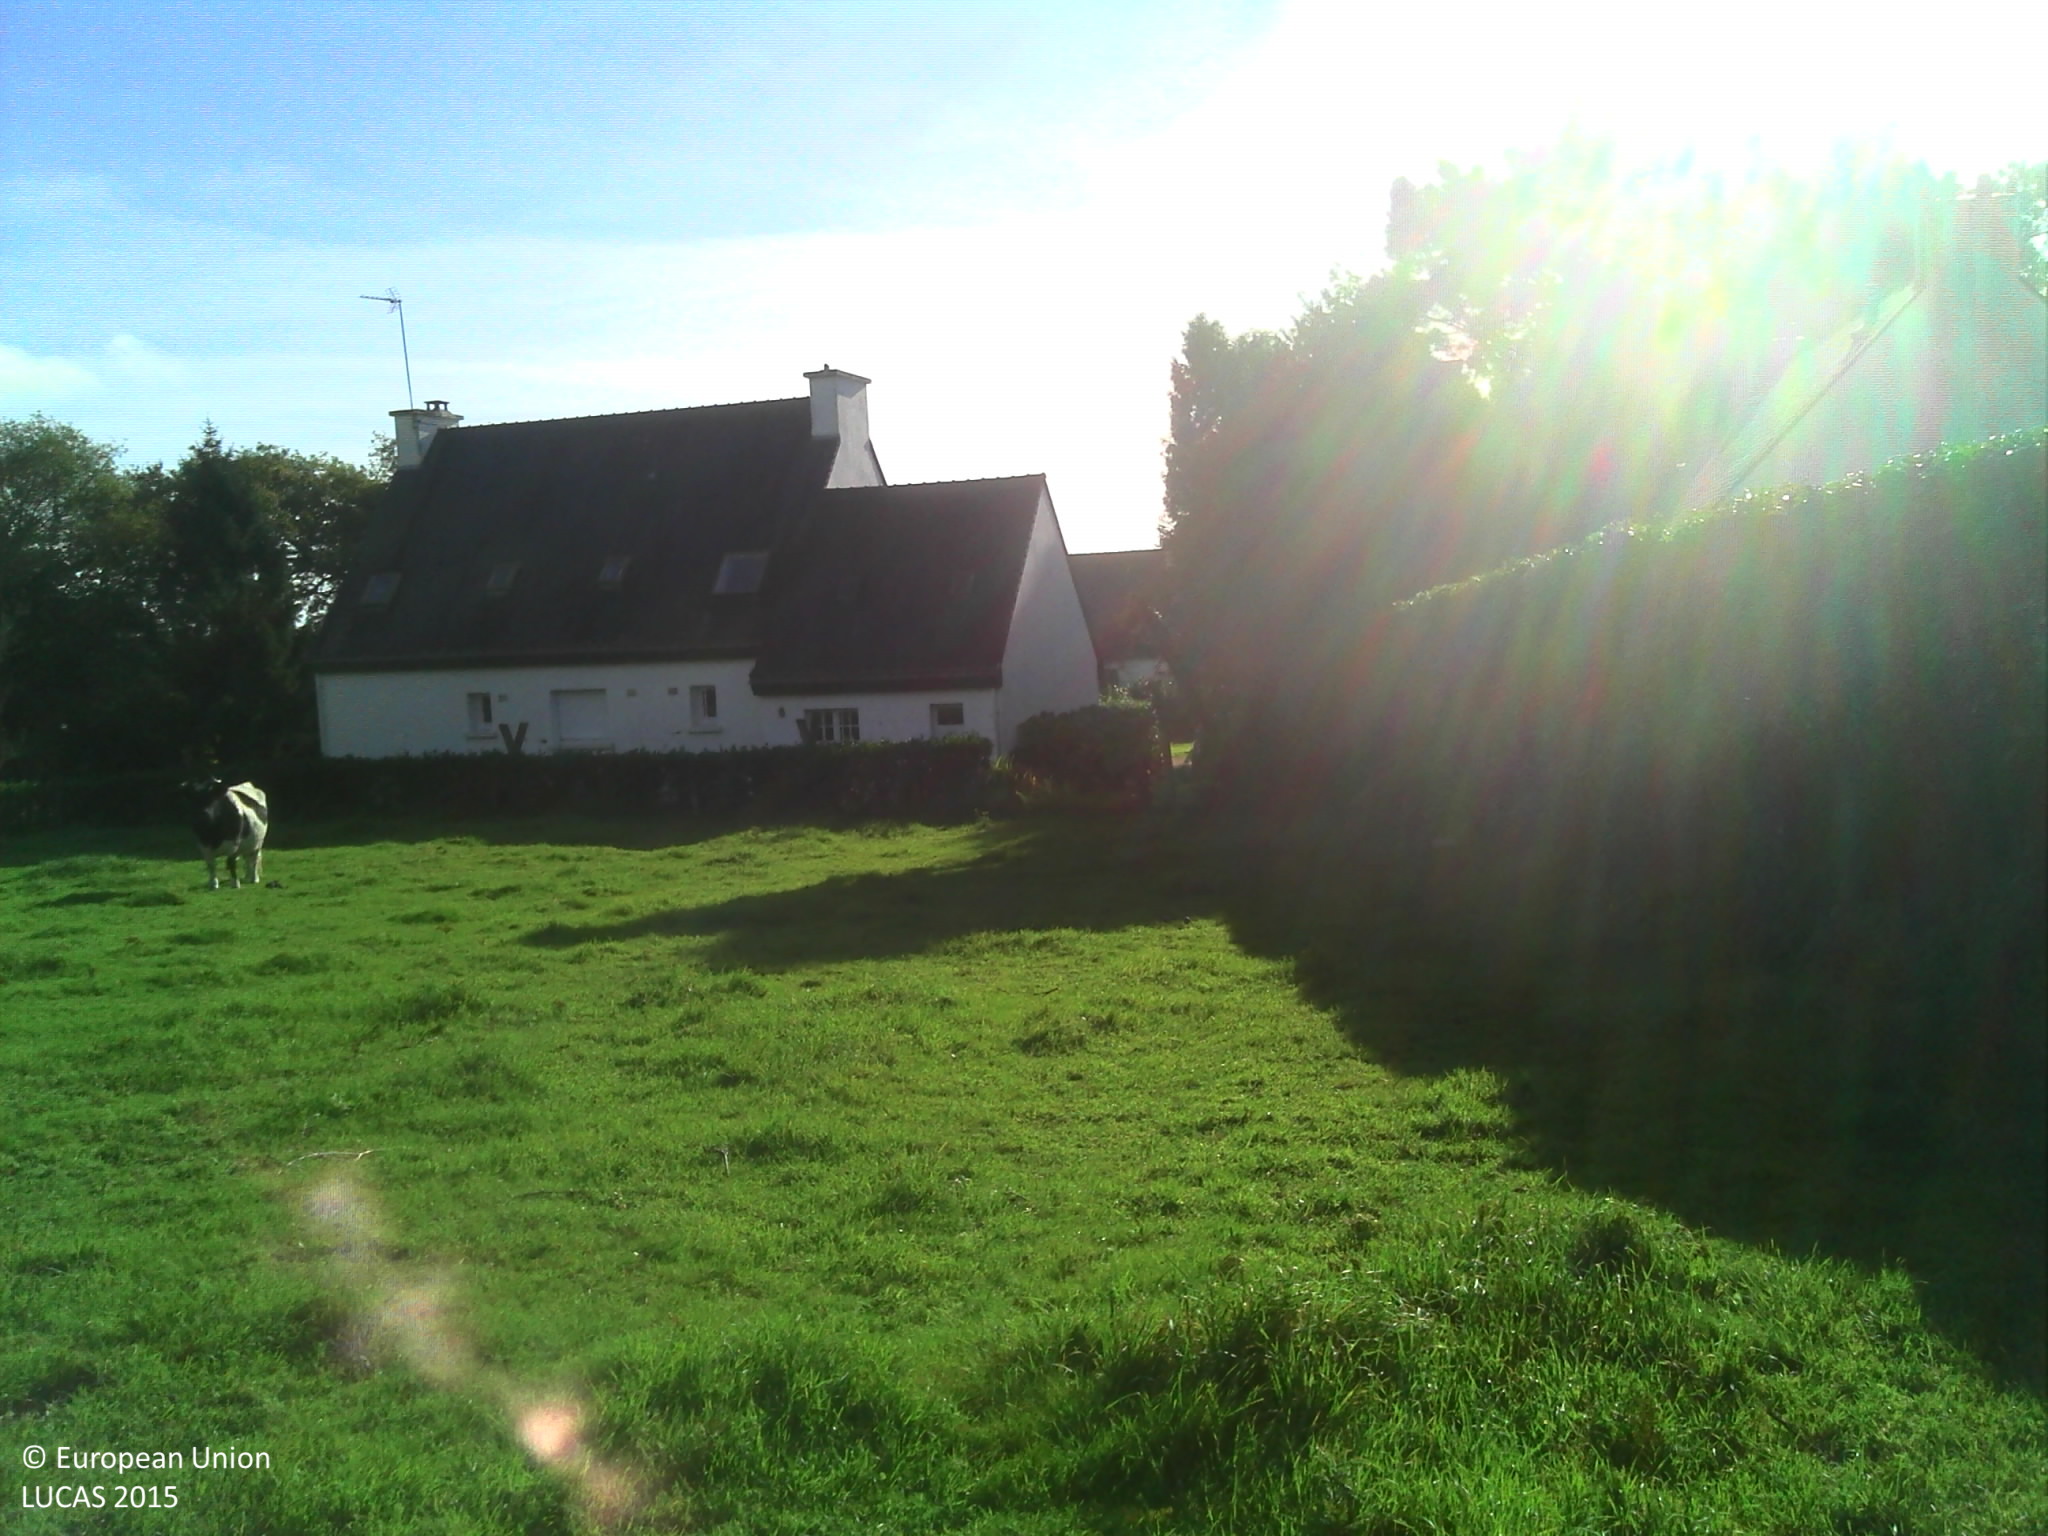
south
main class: Grassland
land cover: Grassland without tree/shrub cover
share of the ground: > 75 %
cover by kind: herbaceous plants 100 %
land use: Agriculture (excluding fallow land and kitchen gardens)
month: November
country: FR
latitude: 47.6240
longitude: -3.0673
